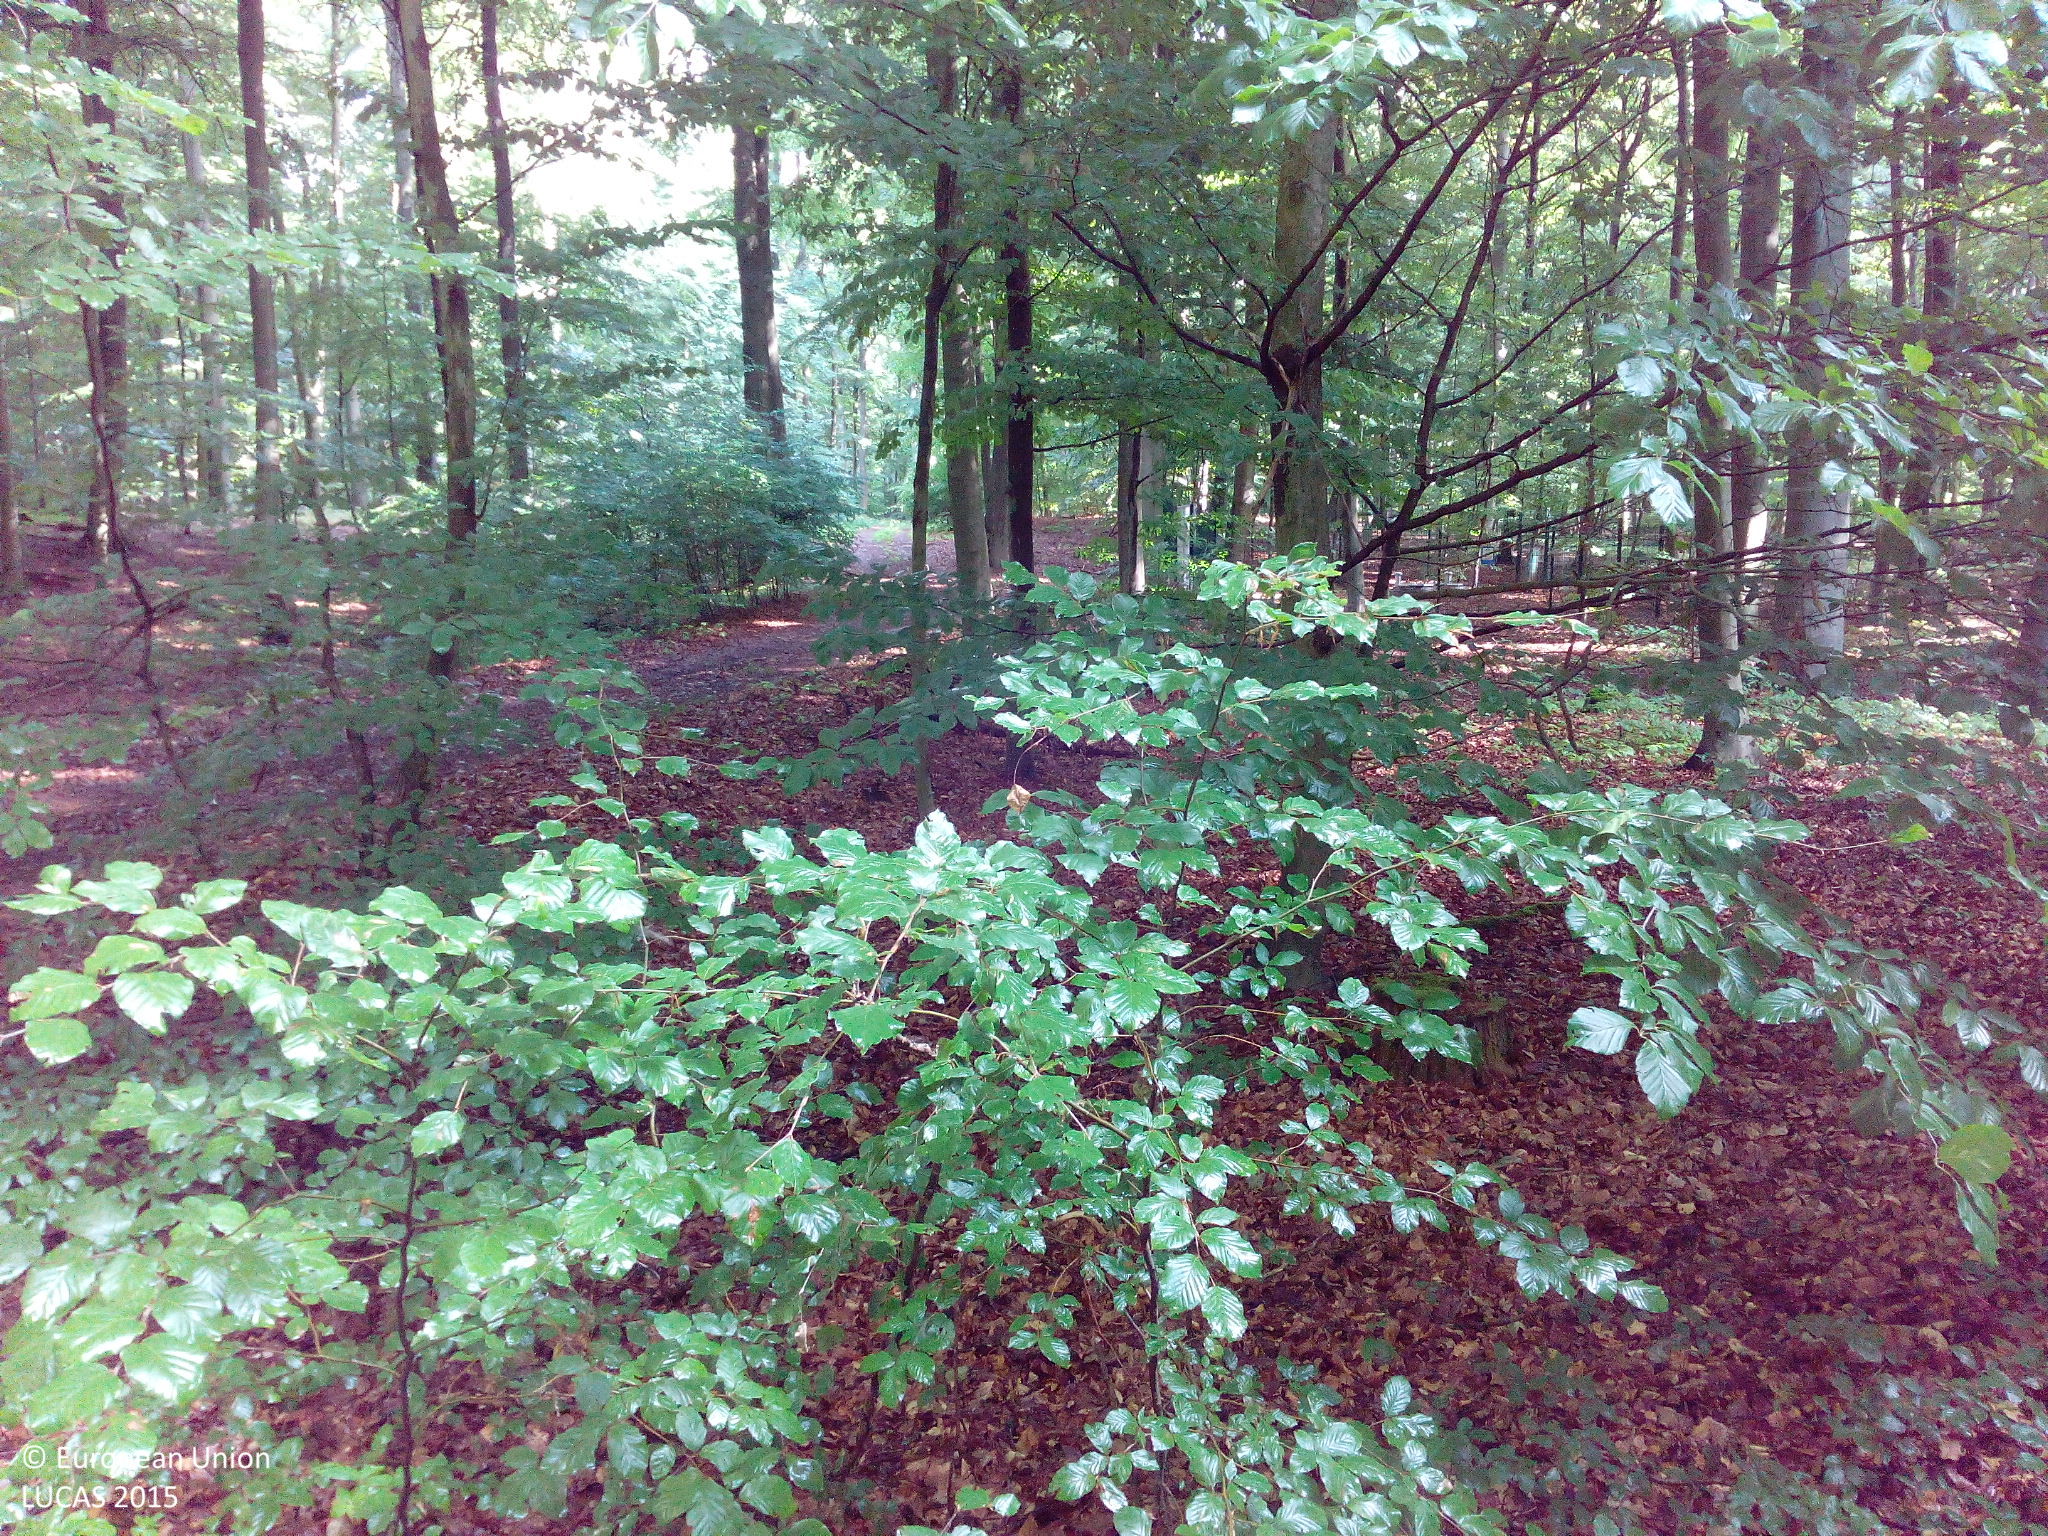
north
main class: Woodland
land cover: Broadleaved woodland
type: beech forest
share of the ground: > 75 %
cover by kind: broadleaved forest trees 90 %, unconsolidated bare surface 10 %
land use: Forestry
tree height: > 5 m
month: July
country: DE
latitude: 52.7744
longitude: 13.5429
